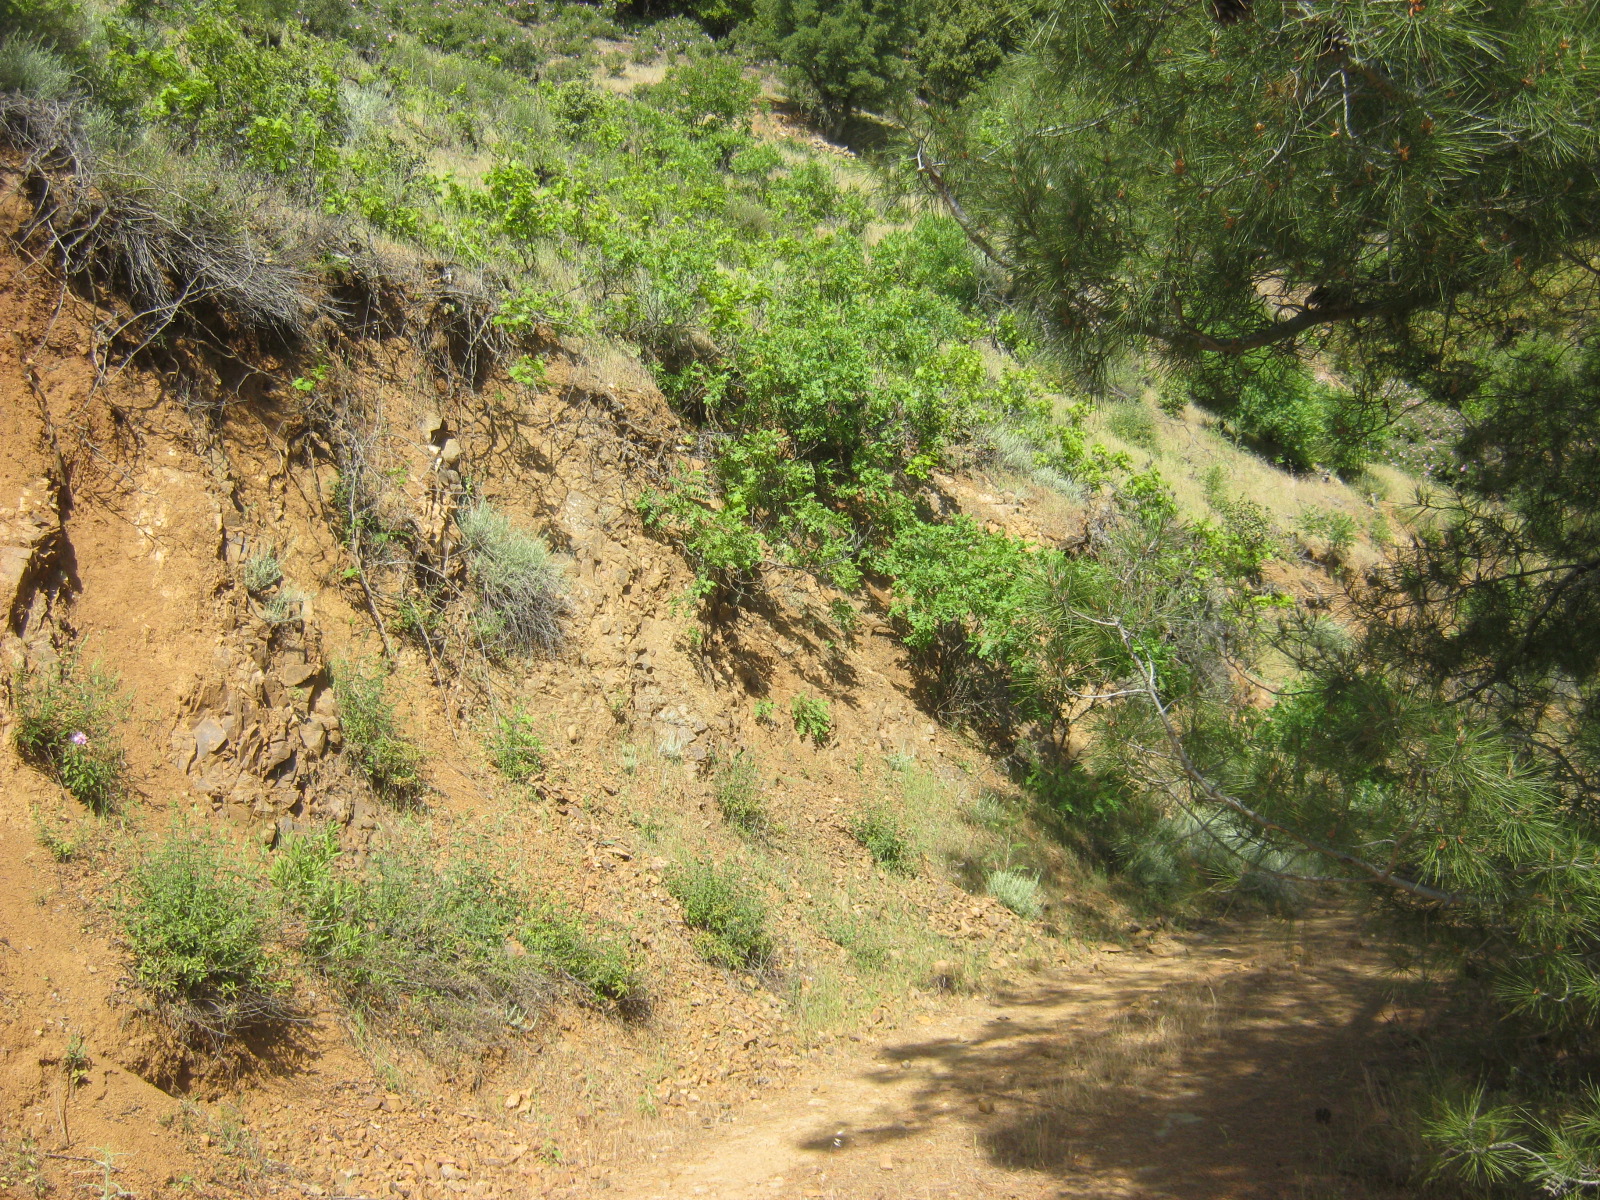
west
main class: Woodland
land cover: Pine dominated coniferous woodland
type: coniferous forest of the mediterranean region
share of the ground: 50 - 75 %
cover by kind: coniferous forest trees 60 %, shrubs 20 %, unconsolidated bare surface 20 %
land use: Forestry
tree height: > 5 m
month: May
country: CY
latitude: 35.0145
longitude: 32.7962
